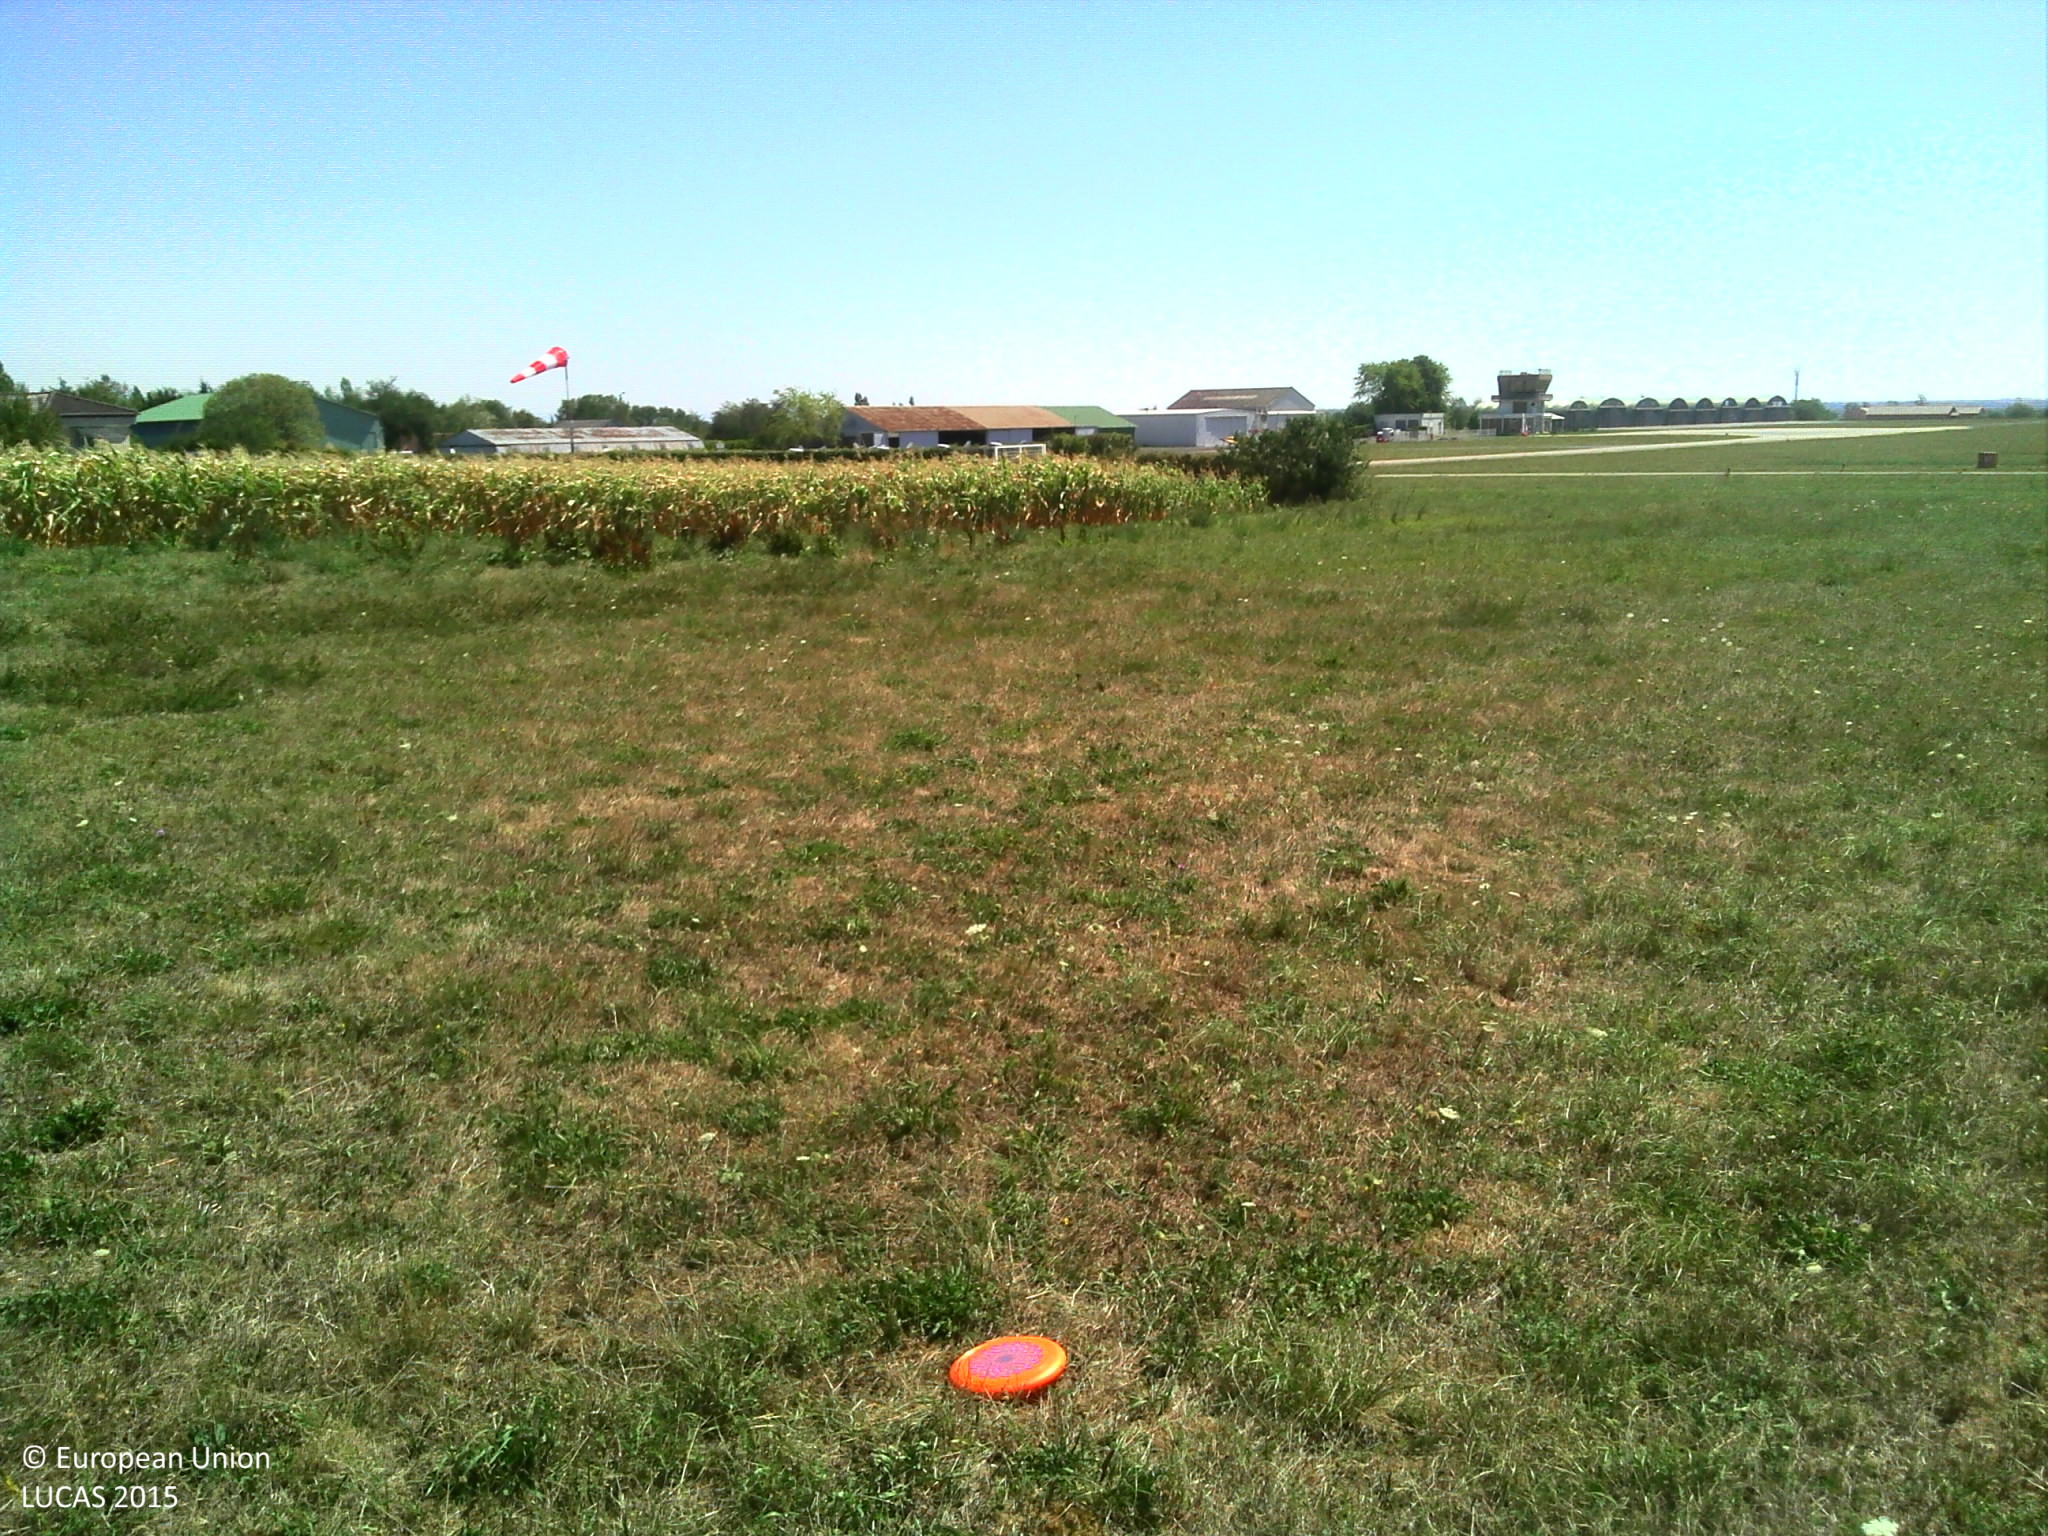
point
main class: Grassland
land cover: Grassland without tree/shrub cover
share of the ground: > 75 %
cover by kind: herbaceous plants 100 %
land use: Air transport
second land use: Agriculture (excluding fallow land and kitchen gardens)
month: August
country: FR
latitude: 46.2968
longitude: 4.7965
